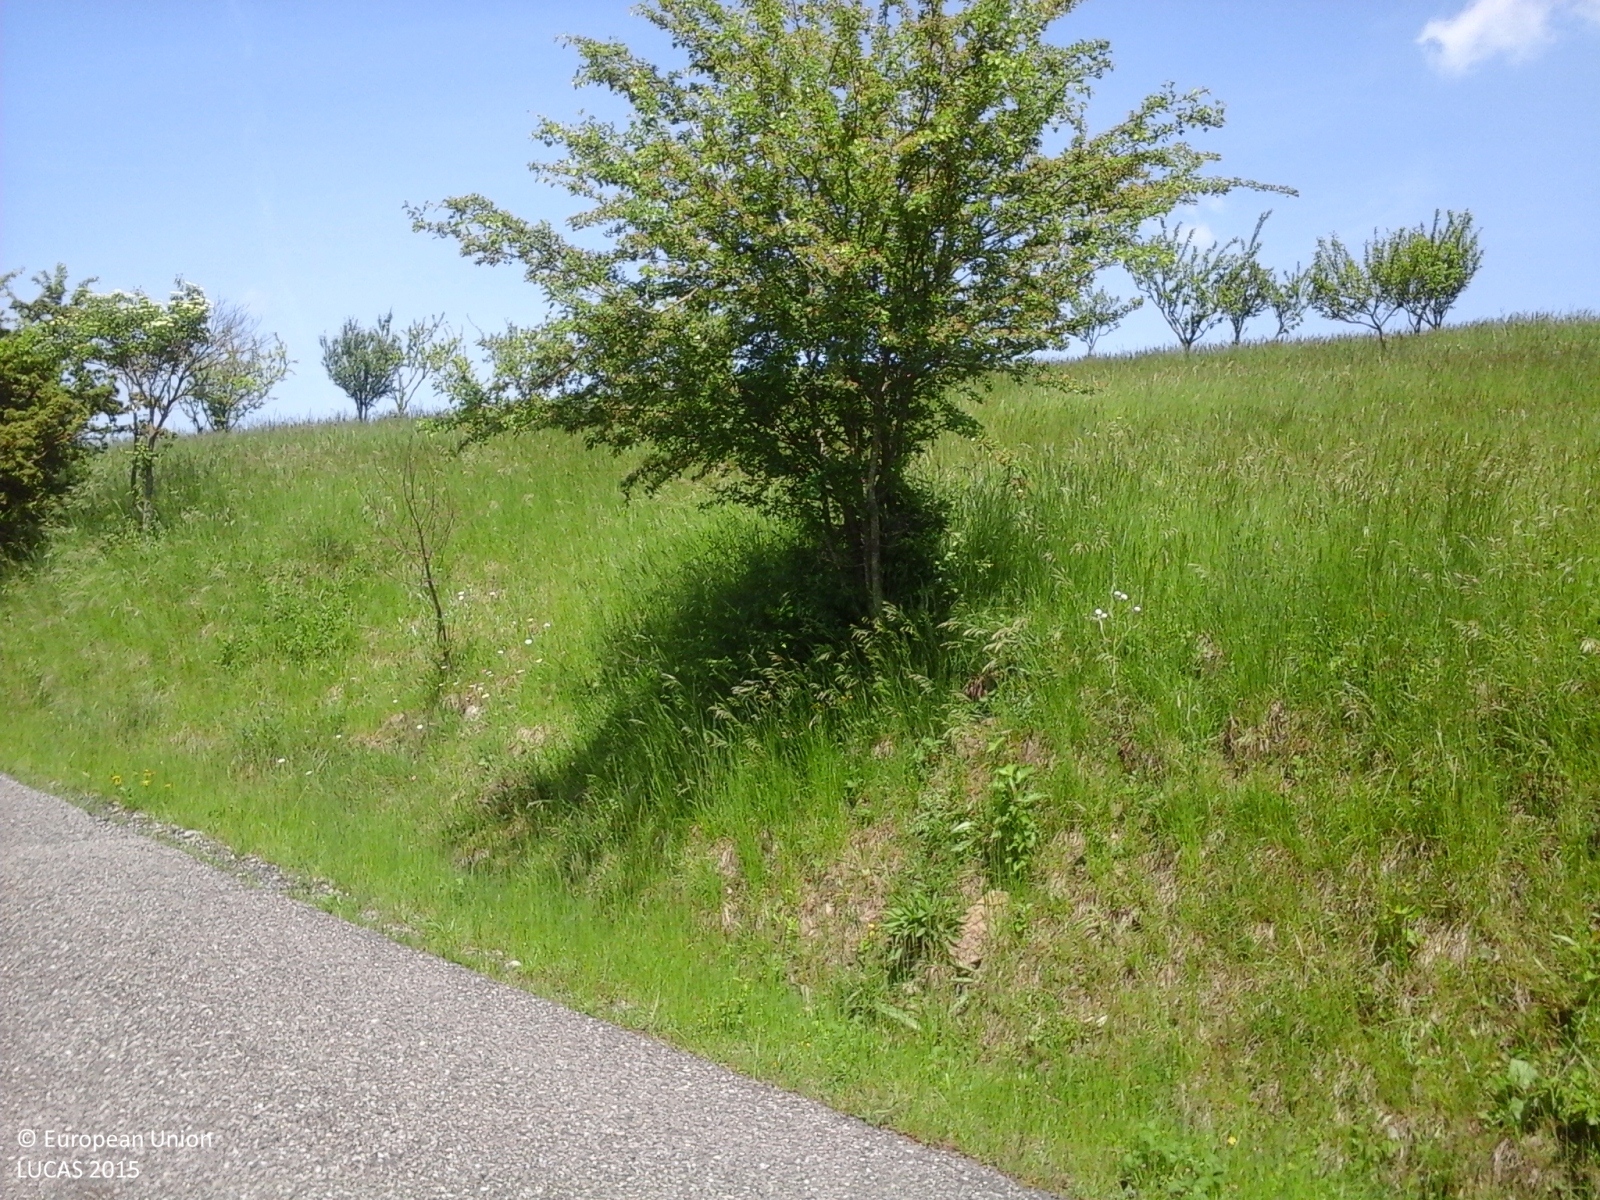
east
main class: Grassland
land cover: Grassland with sparse tree/shrub cover
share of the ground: > 75 %
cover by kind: herbaceous plants 90 %, broadleaved forest trees 5 %, shrubs 5 %
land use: Agriculture (excluding fallow land and kitchen gardens)
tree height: > 5 m
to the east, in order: Grassland with sparse tree/shrub cover; Managed hedges; Fences; Grass margins; Tracks; Grass margins; Managed hedges; Grassland without tree/shrub cover; Fences; Broadleaved woodland; Grassland with sparse tree/shrub cover; Fences; Other fruit trees and berries; Spontaneously vegetated surfaces; Grass margins; Paved roads, cycling and walking lanes; Grass margins; Spontaneously vegetated surfaces
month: May
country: IT
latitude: 44.7646
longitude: 9.6092
